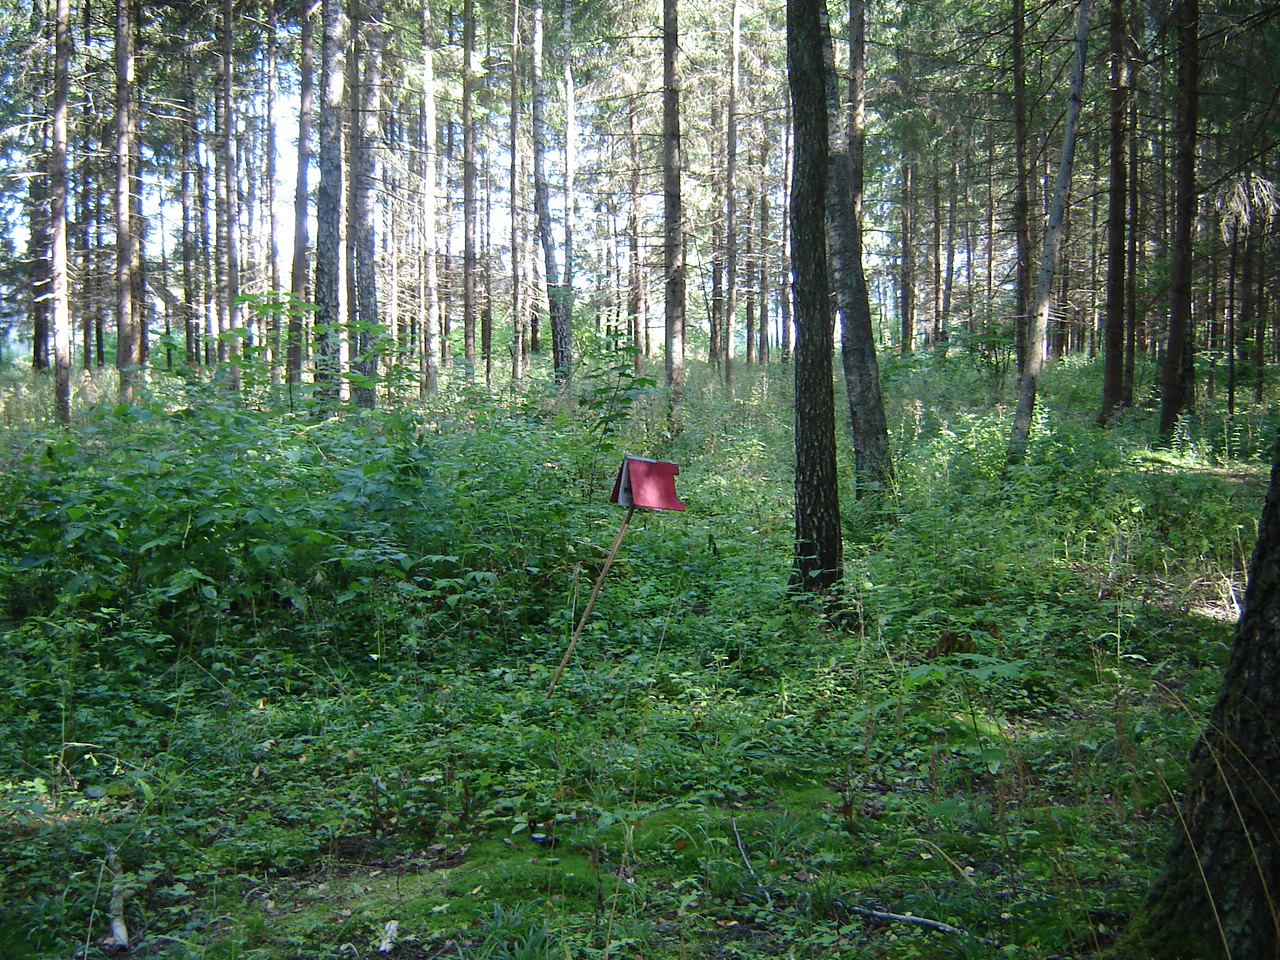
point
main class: Woodland
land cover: Spruce dominated mixed woodland
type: hemiboreal forest and nemoral coniferous forest and mixed broadleaved-coniferous forest
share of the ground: > 75 %
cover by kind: coniferous forest trees 55 %, broadleaved forest trees 25 %, herbaceous plants 10 %, shrubs 5 %, lichens and mosses 5 %
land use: Forestry
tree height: > 5 m
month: August
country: LT
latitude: 54.8188
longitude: 25.3270
